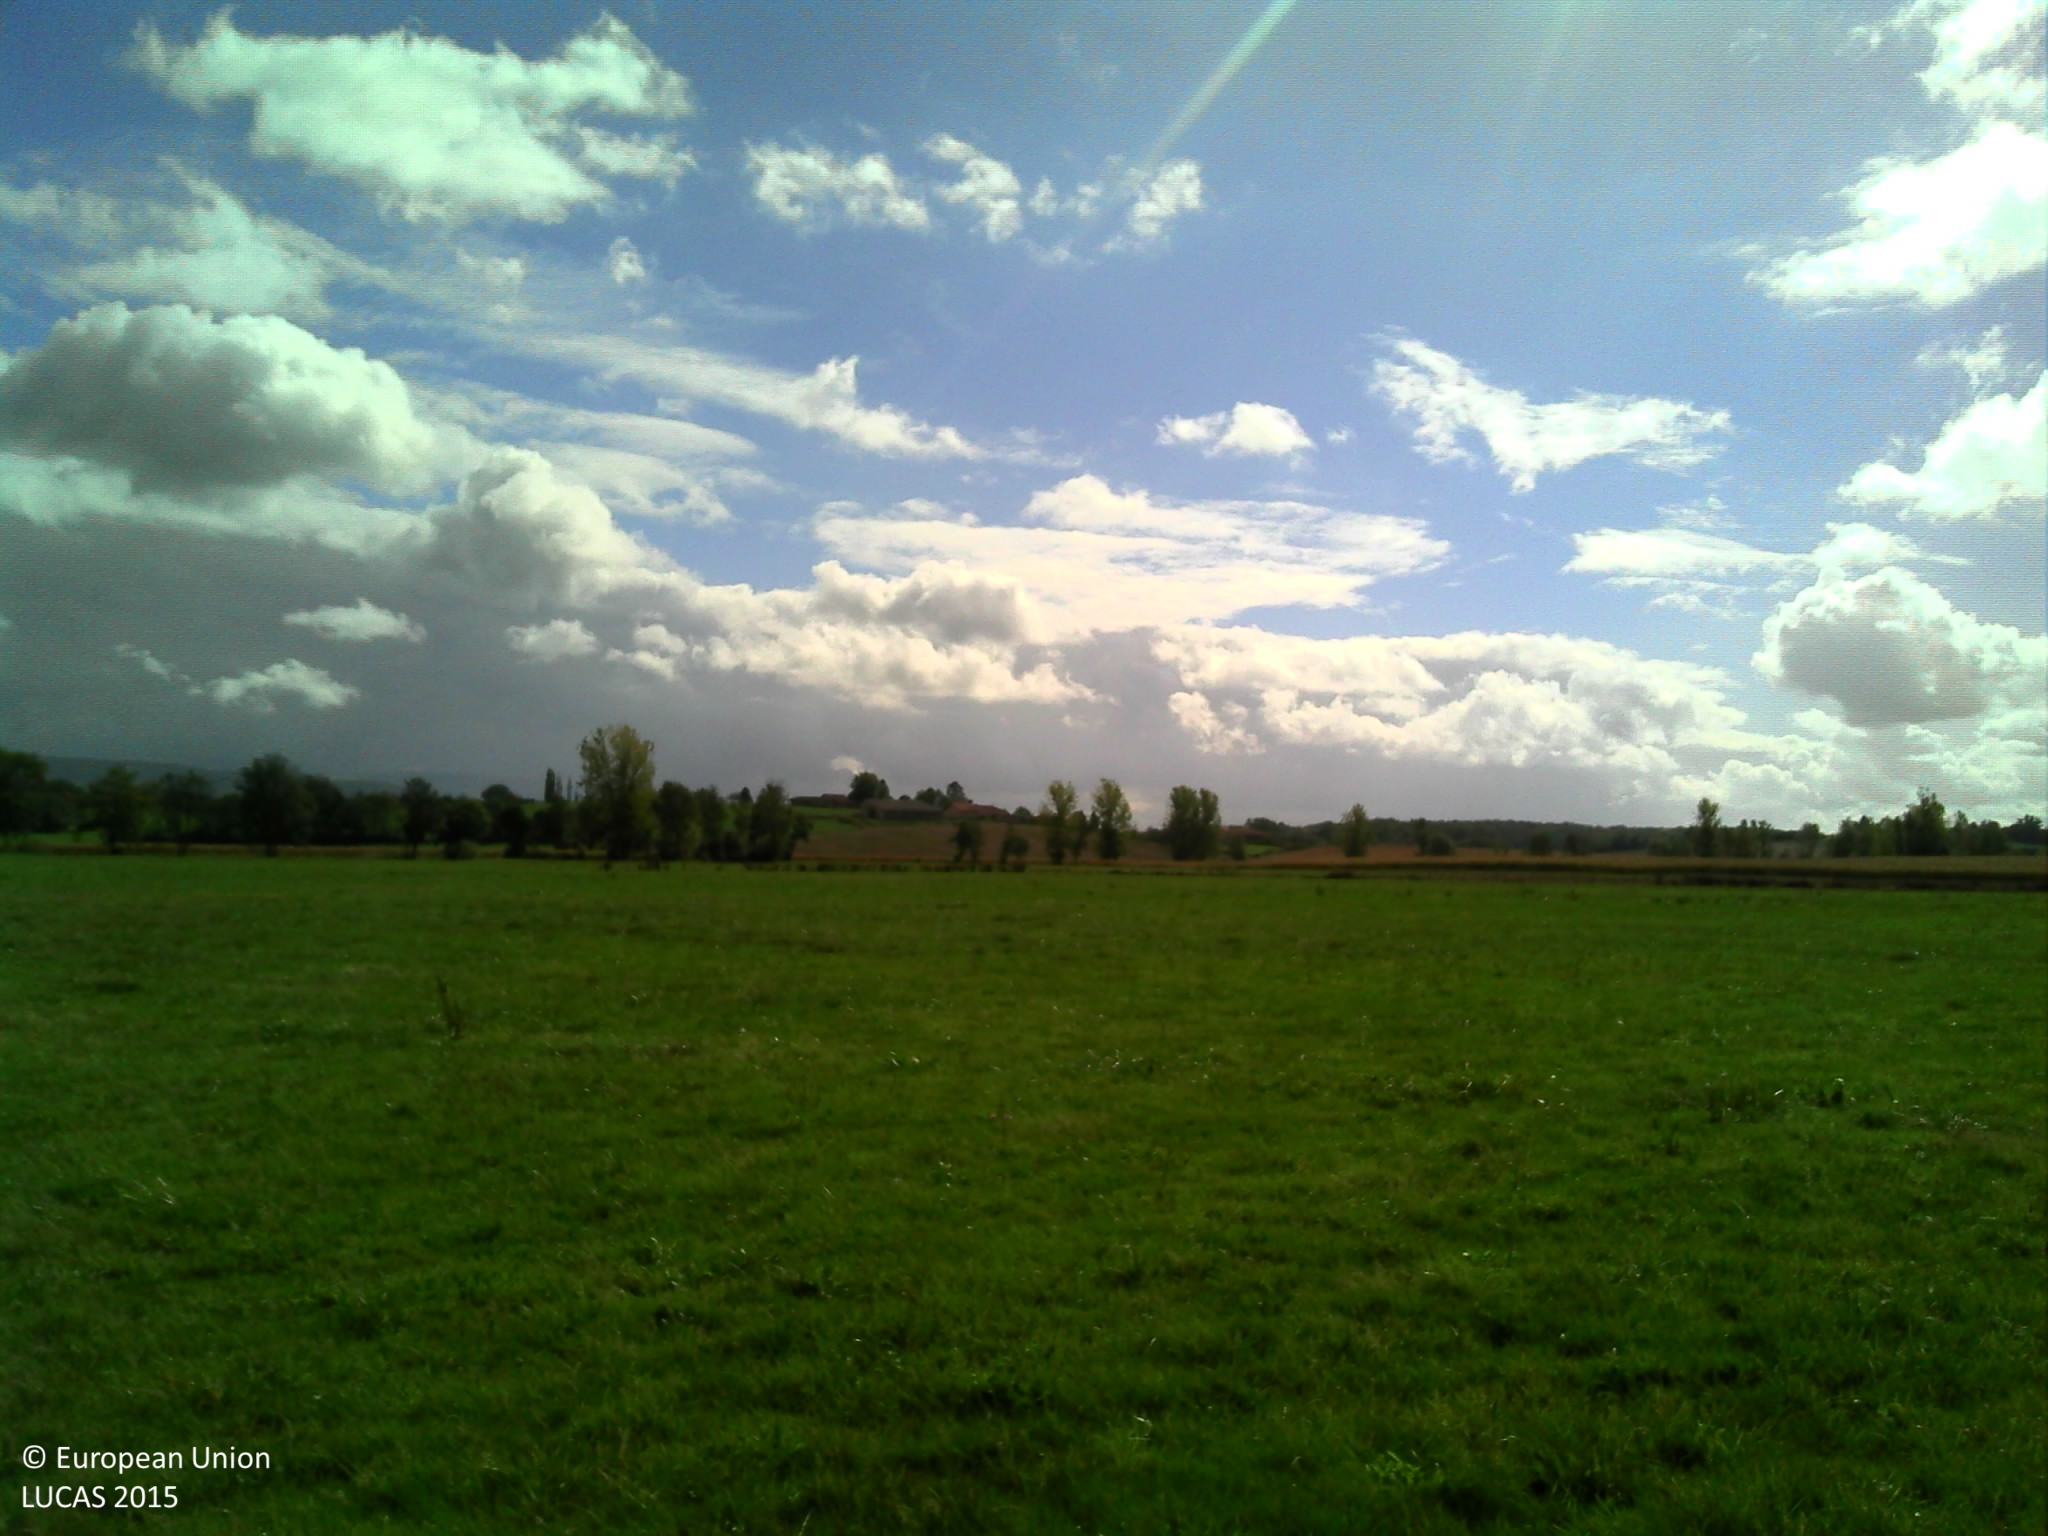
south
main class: Cropland
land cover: Temporary grasslands
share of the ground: > 75 %
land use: Agriculture (excluding fallow land and kitchen gardens)
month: October
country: FR
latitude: 46.4094
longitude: 5.2805
